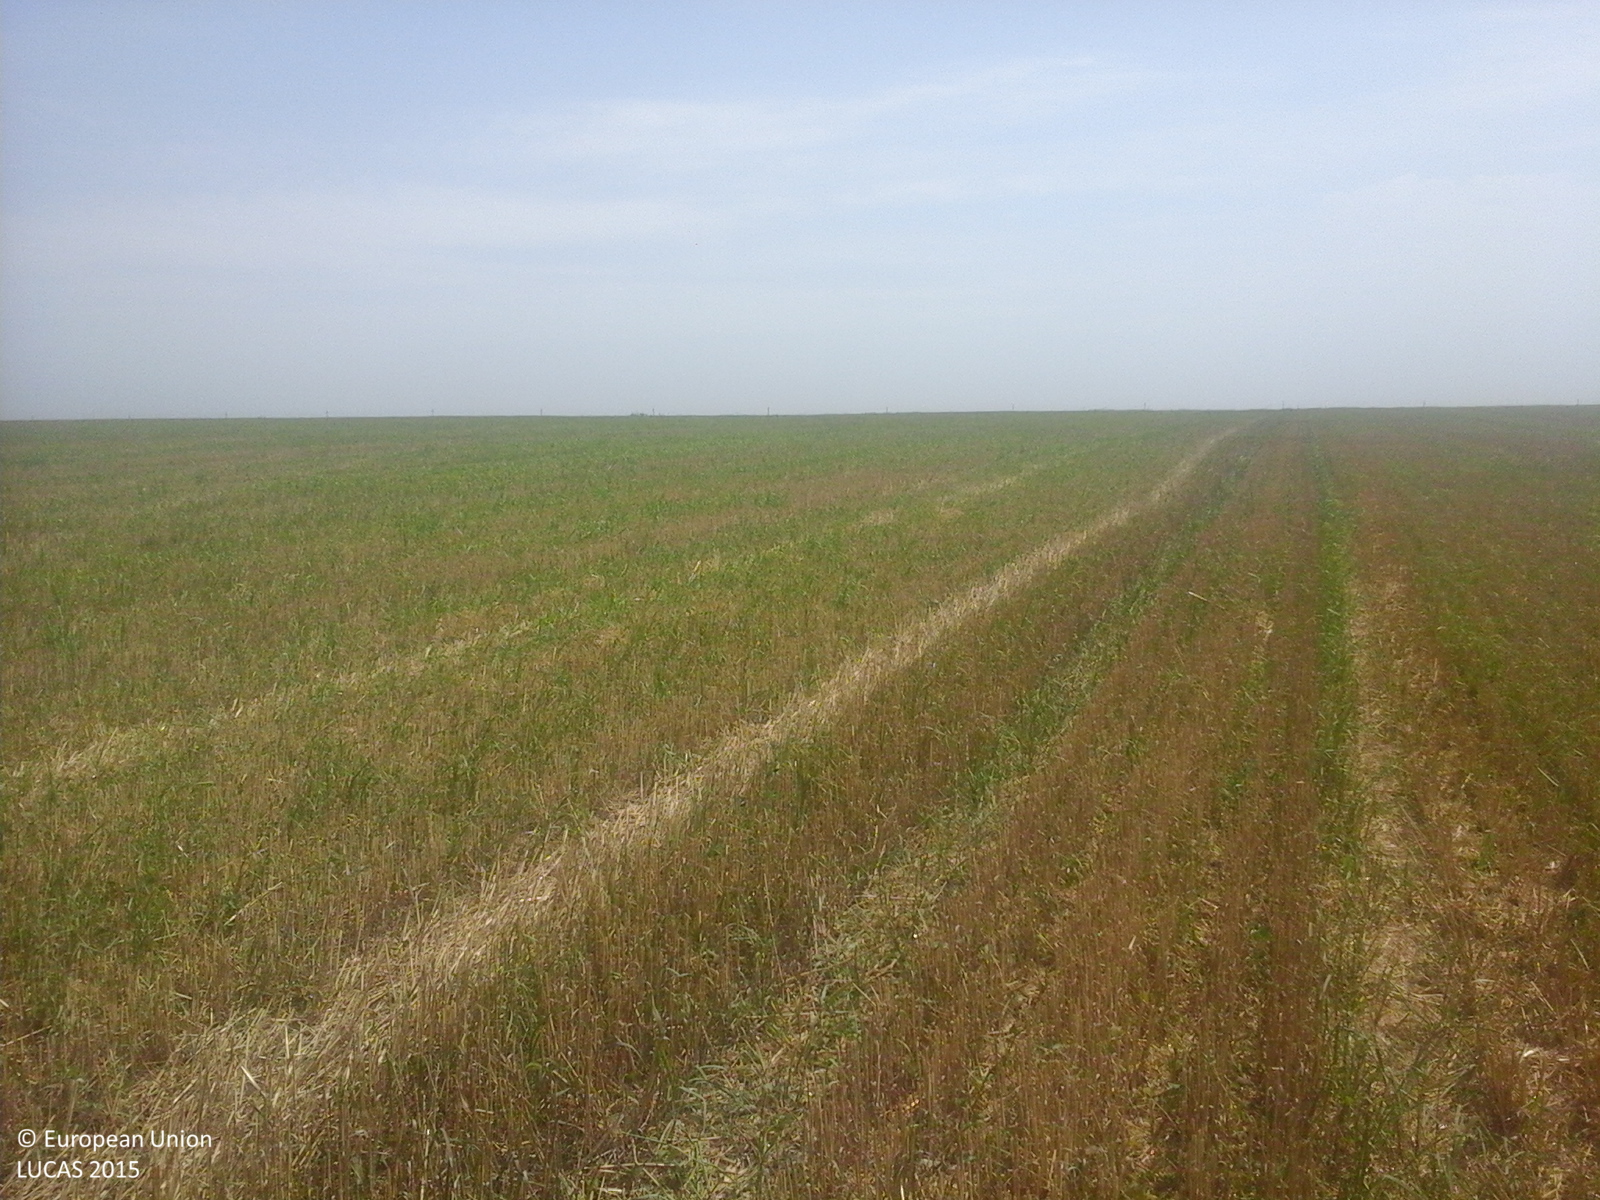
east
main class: Cropland
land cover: Durum wheat
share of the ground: > 75 %
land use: Agriculture (excluding fallow land and kitchen gardens)
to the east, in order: Durum wheat
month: August
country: RO
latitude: 43.8664
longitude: 28.2115
